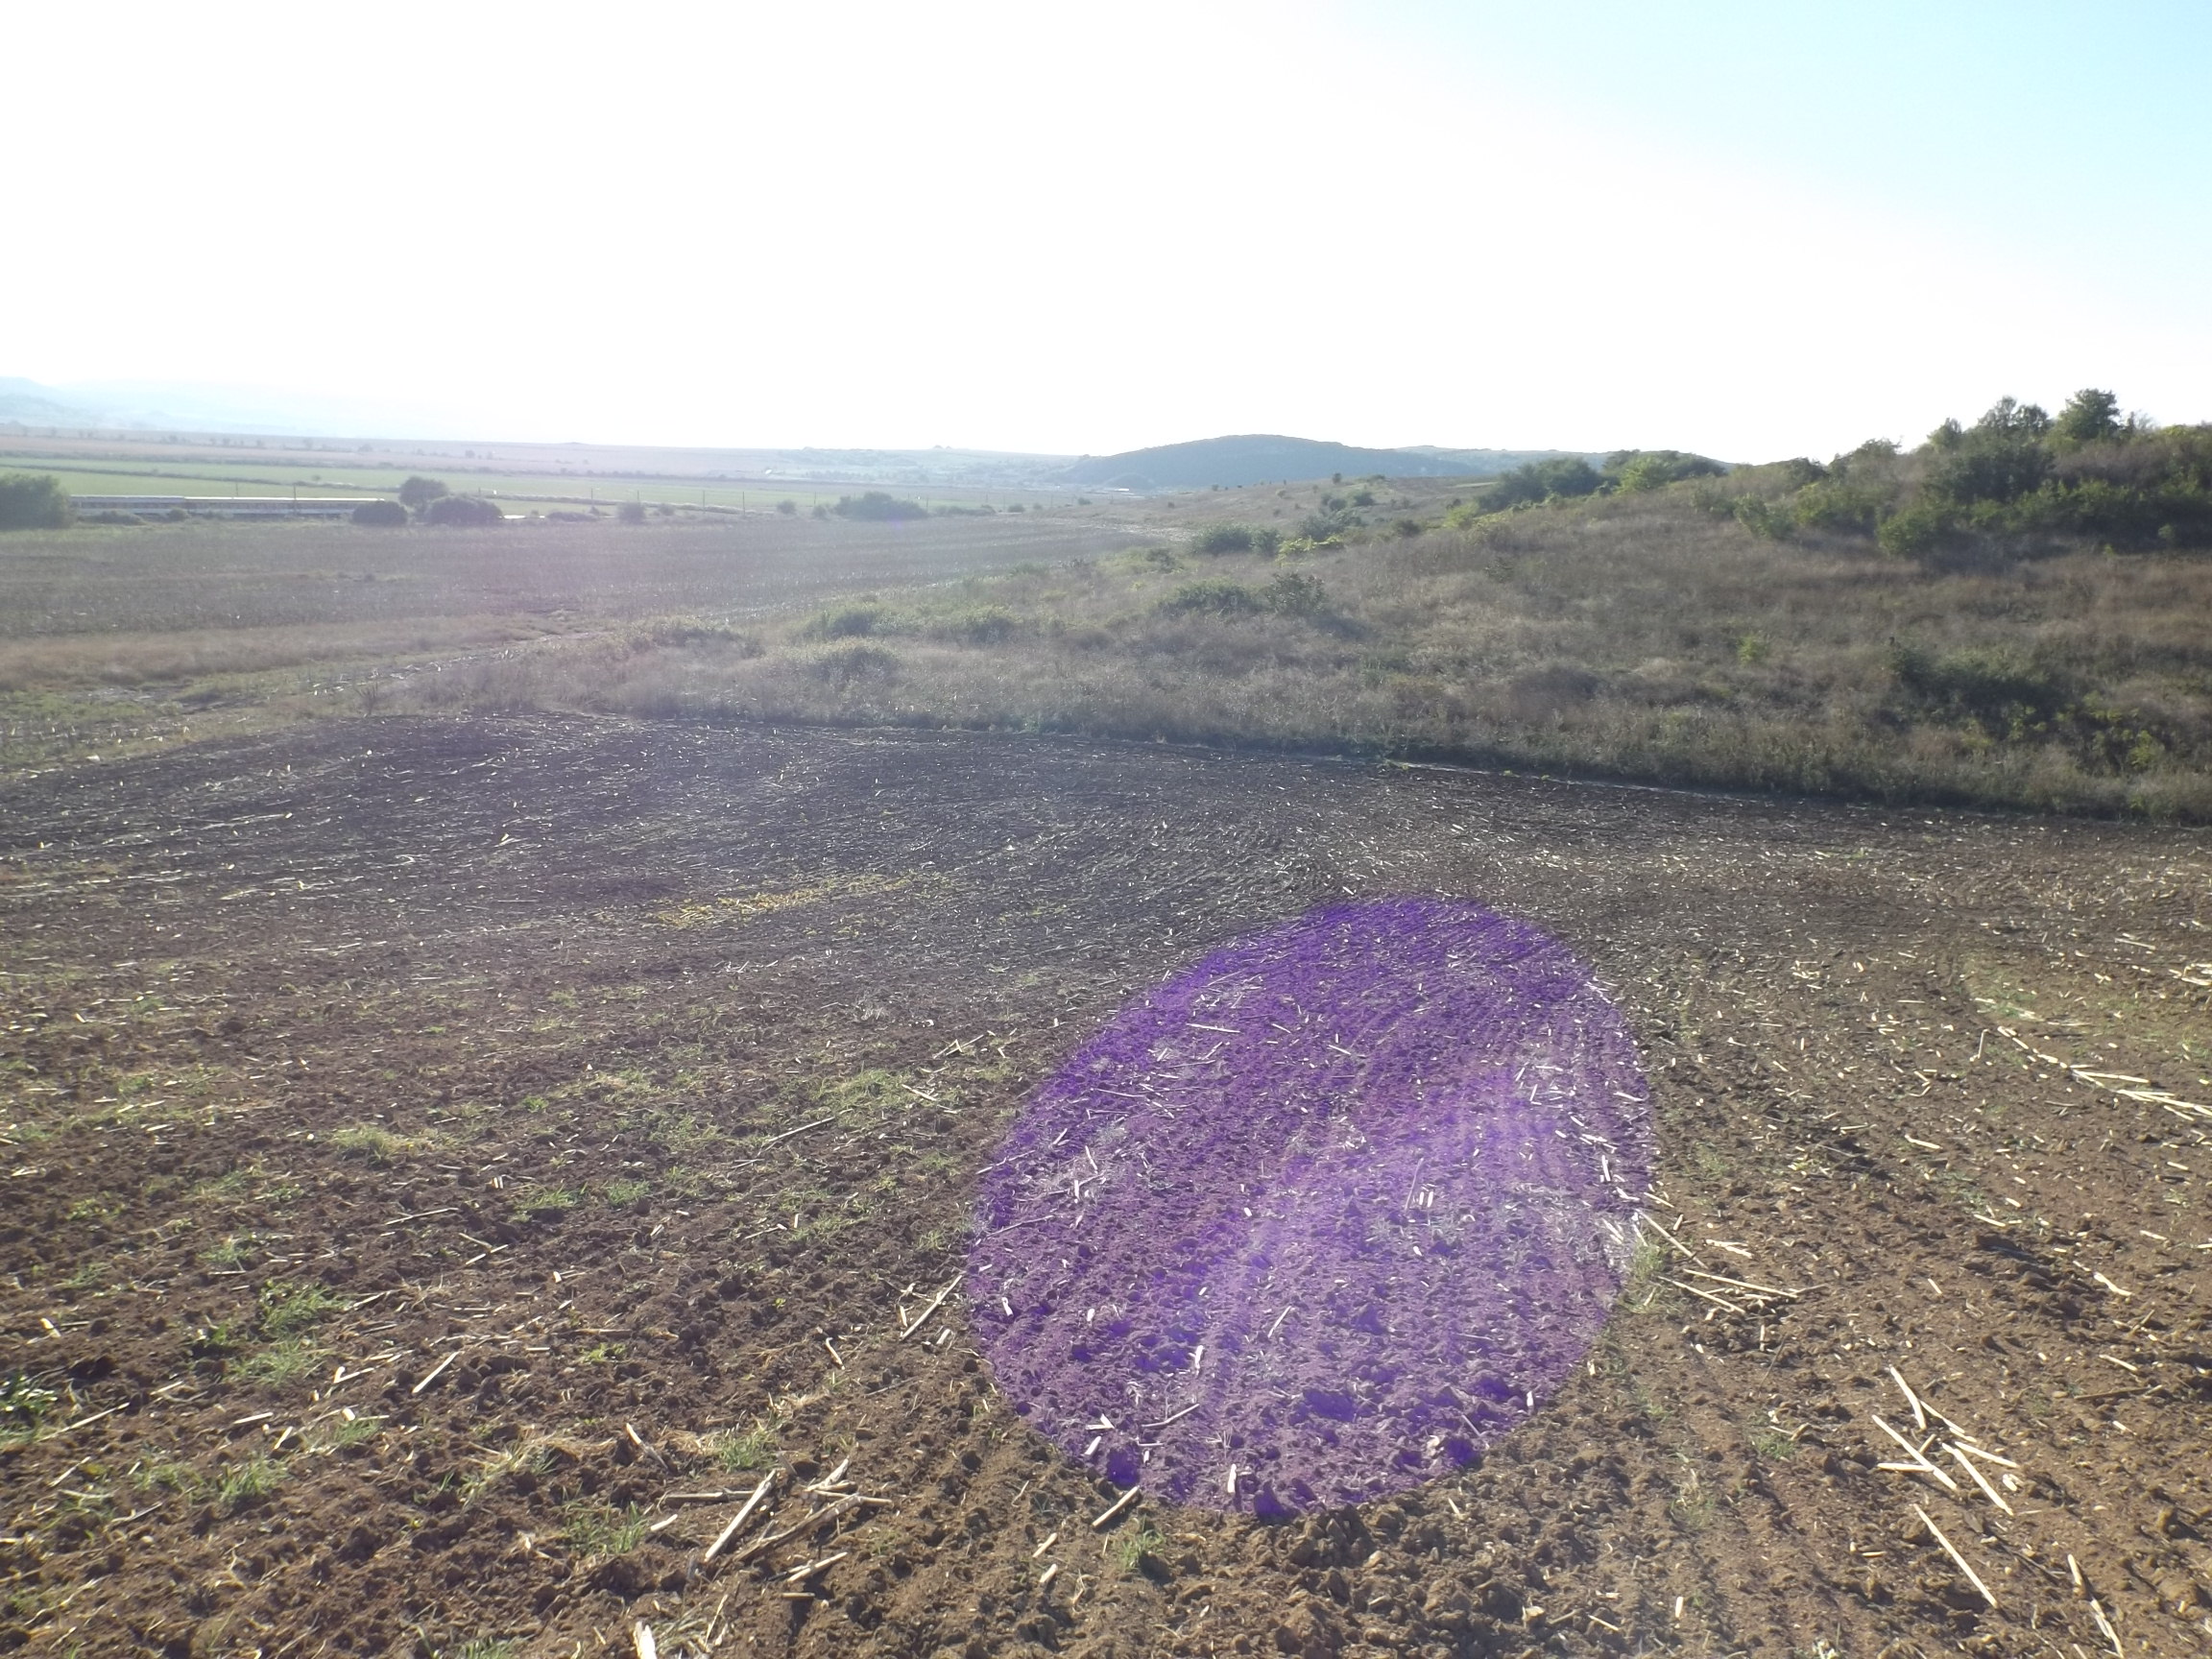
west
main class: Cropland
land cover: Sunflower
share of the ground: < 10 %
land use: Agriculture (excluding fallow land and kitchen gardens)
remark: Harvested field
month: September
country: BG
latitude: 43.1265
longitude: 27.4947
